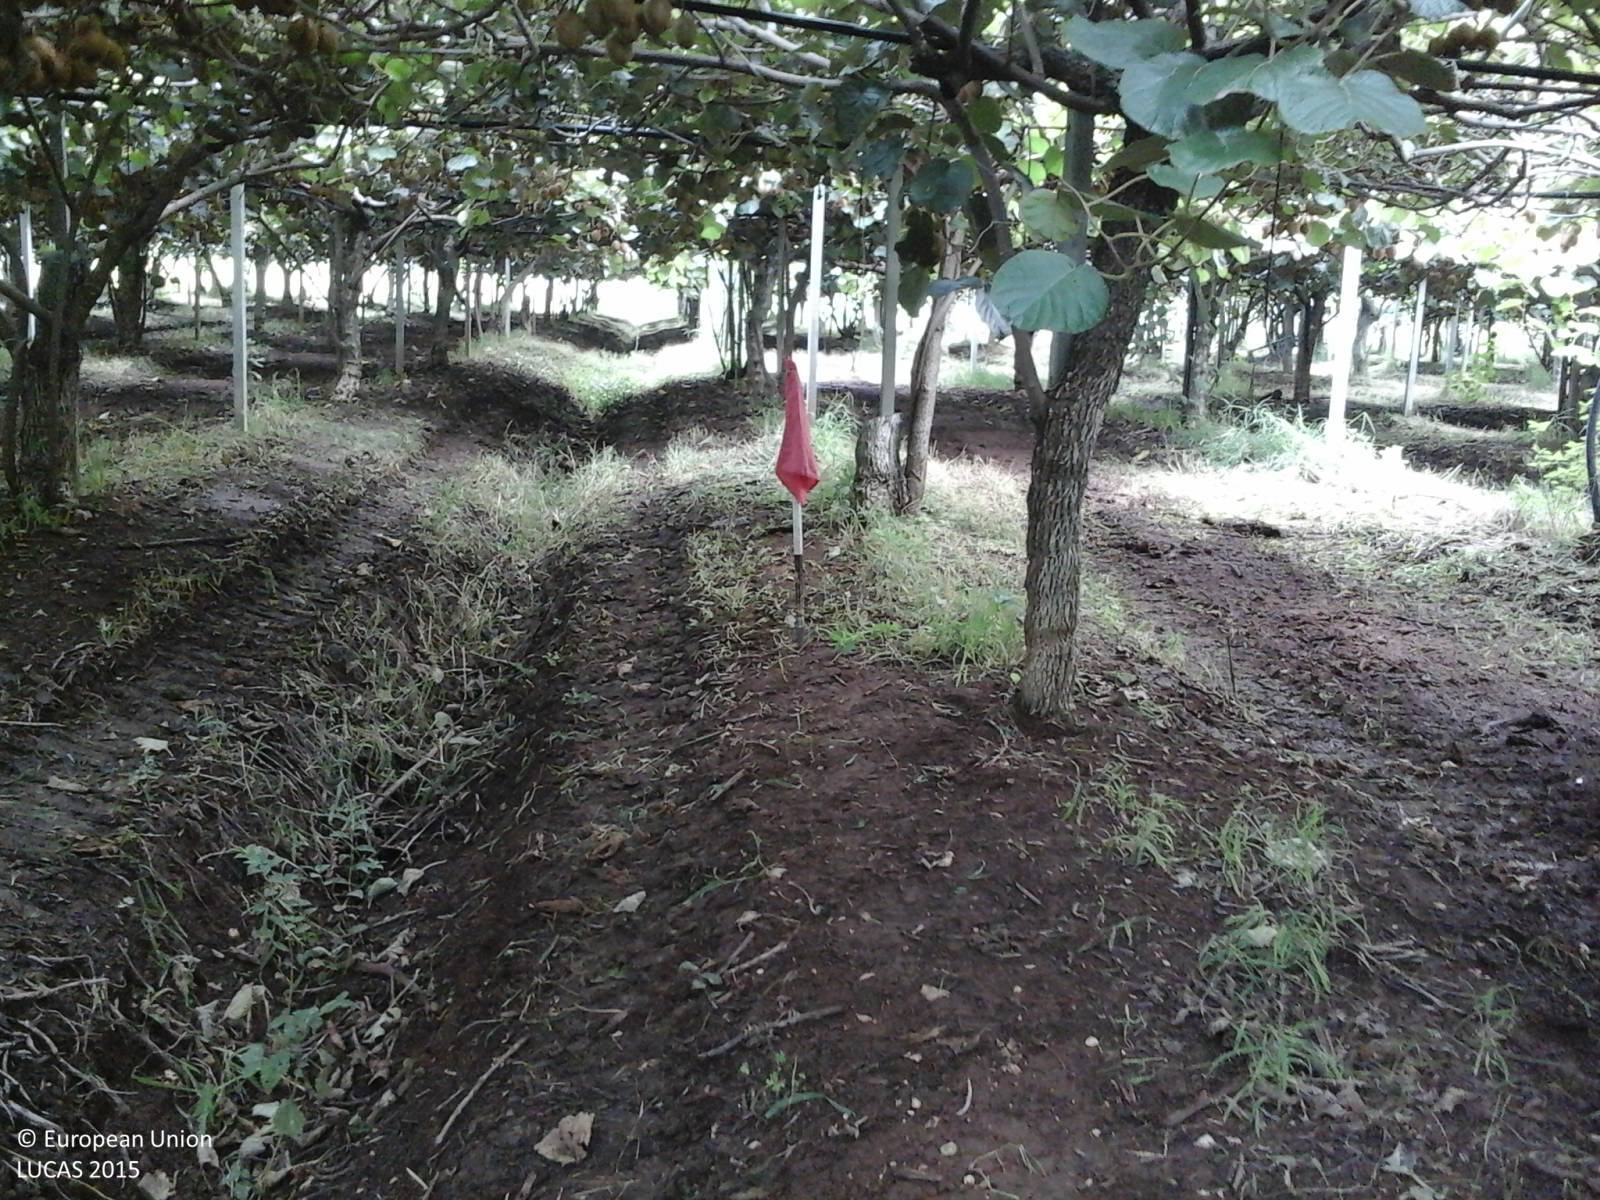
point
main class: Cropland
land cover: Other fruit trees and berries
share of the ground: > 75 %
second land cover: Spontaneously vegetated surfaces
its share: > 75 %
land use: Agriculture (excluding fallow land and kitchen gardens)
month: August
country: IT
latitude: 41.4873
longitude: 13.0421
